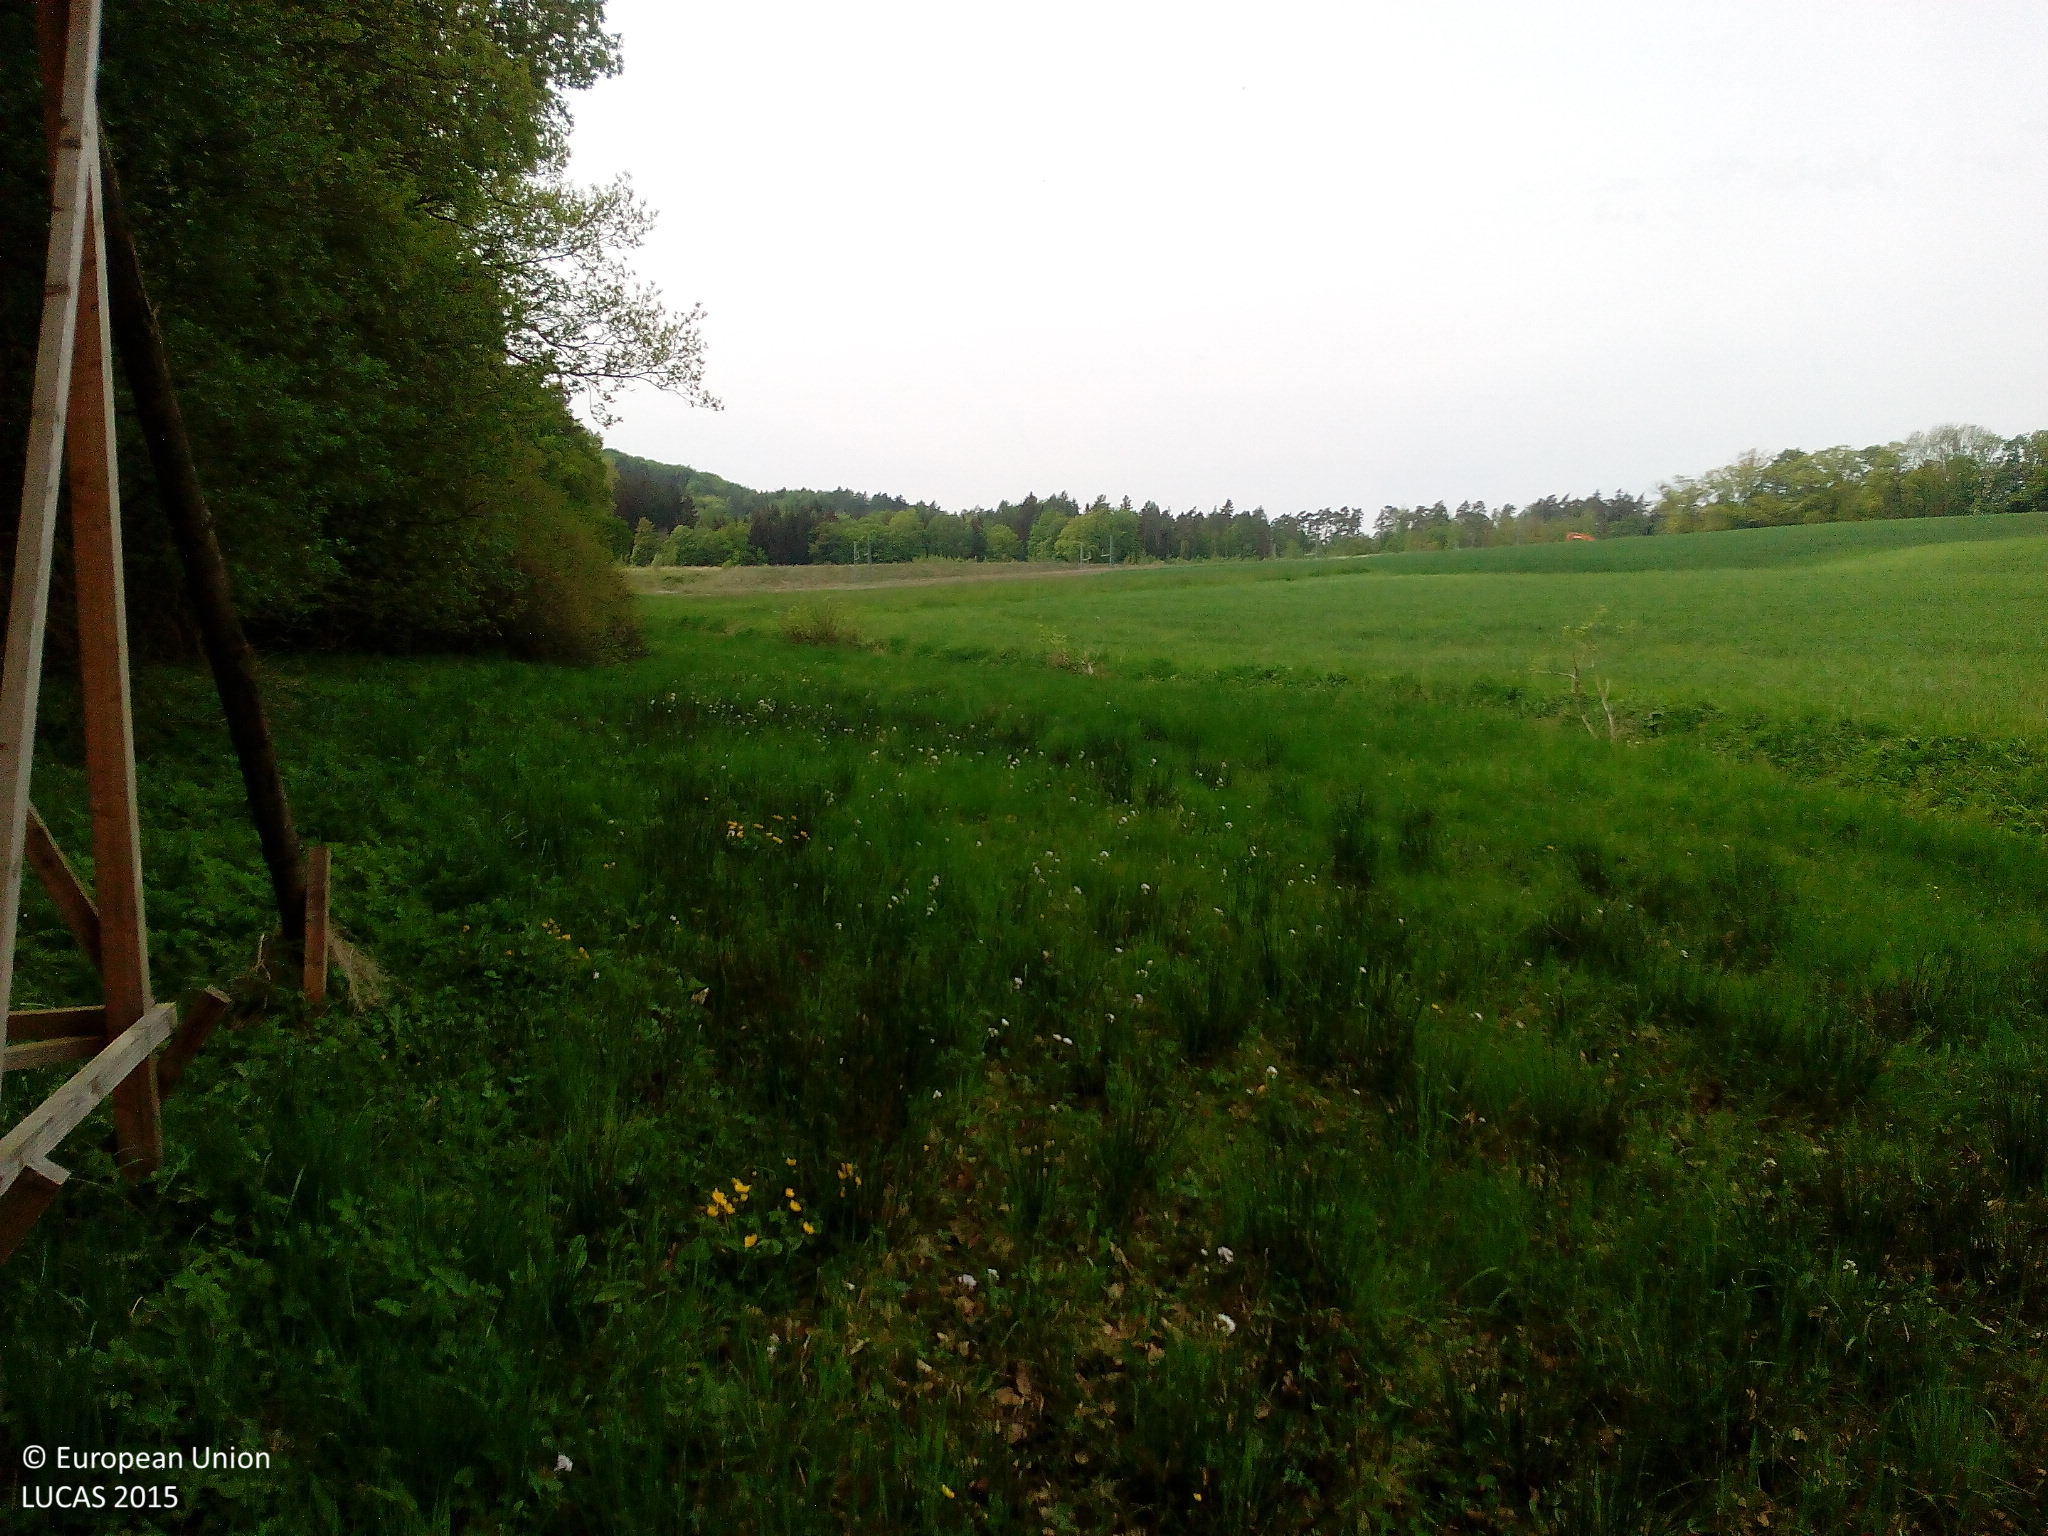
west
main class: Grassland
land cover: Grassland without tree/shrub cover
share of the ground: > 75 %
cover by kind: herbaceous plants 100 %
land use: Agriculture (excluding fallow land and kitchen gardens)
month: May
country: DE
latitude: 50.2696
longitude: 11.0239
